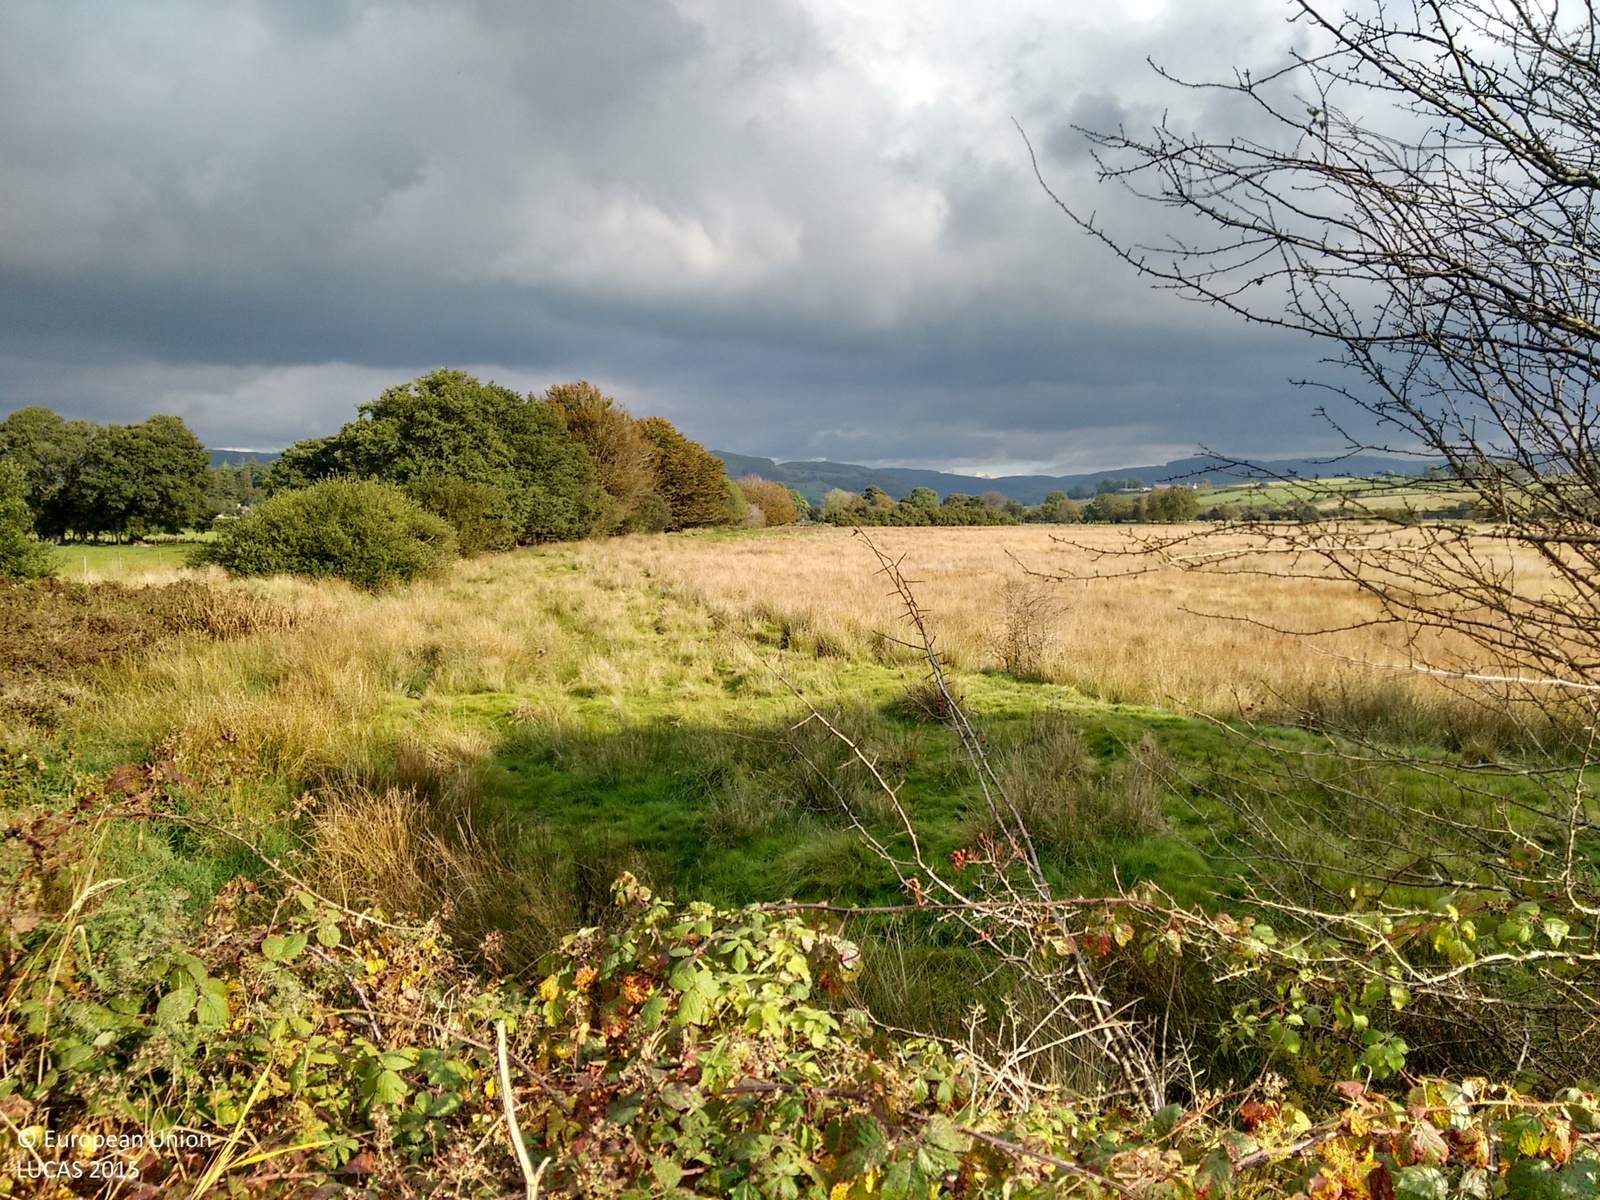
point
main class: Grassland
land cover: Grassland without tree/shrub cover
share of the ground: > 75 %
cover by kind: herbaceous plants 100 %
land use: Agriculture (excluding fallow land and kitchen gardens)
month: October
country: GB
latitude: 52.2861
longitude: -3.8869
